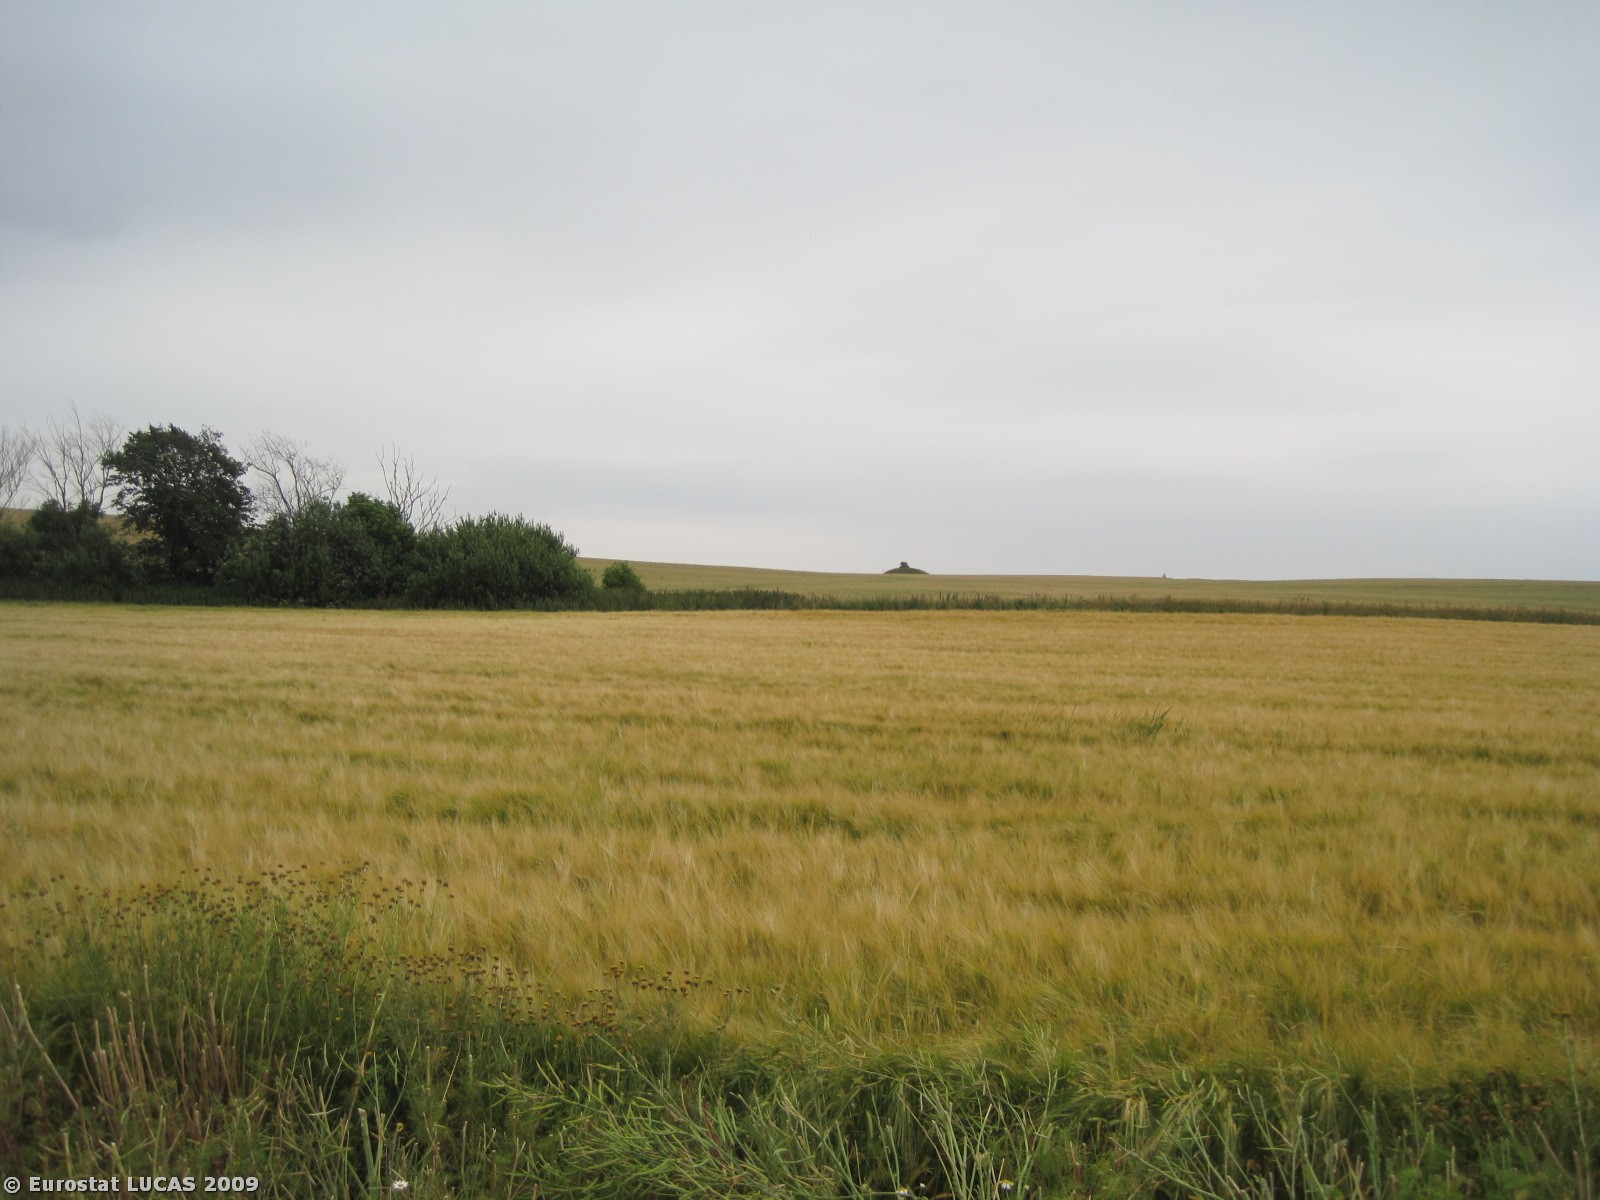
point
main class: Cropland
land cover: Barley
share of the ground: > 75 %
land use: Agriculture (excluding fallow land and kitchen gardens)
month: July
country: DK
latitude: 56.8264
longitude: 8.5109
